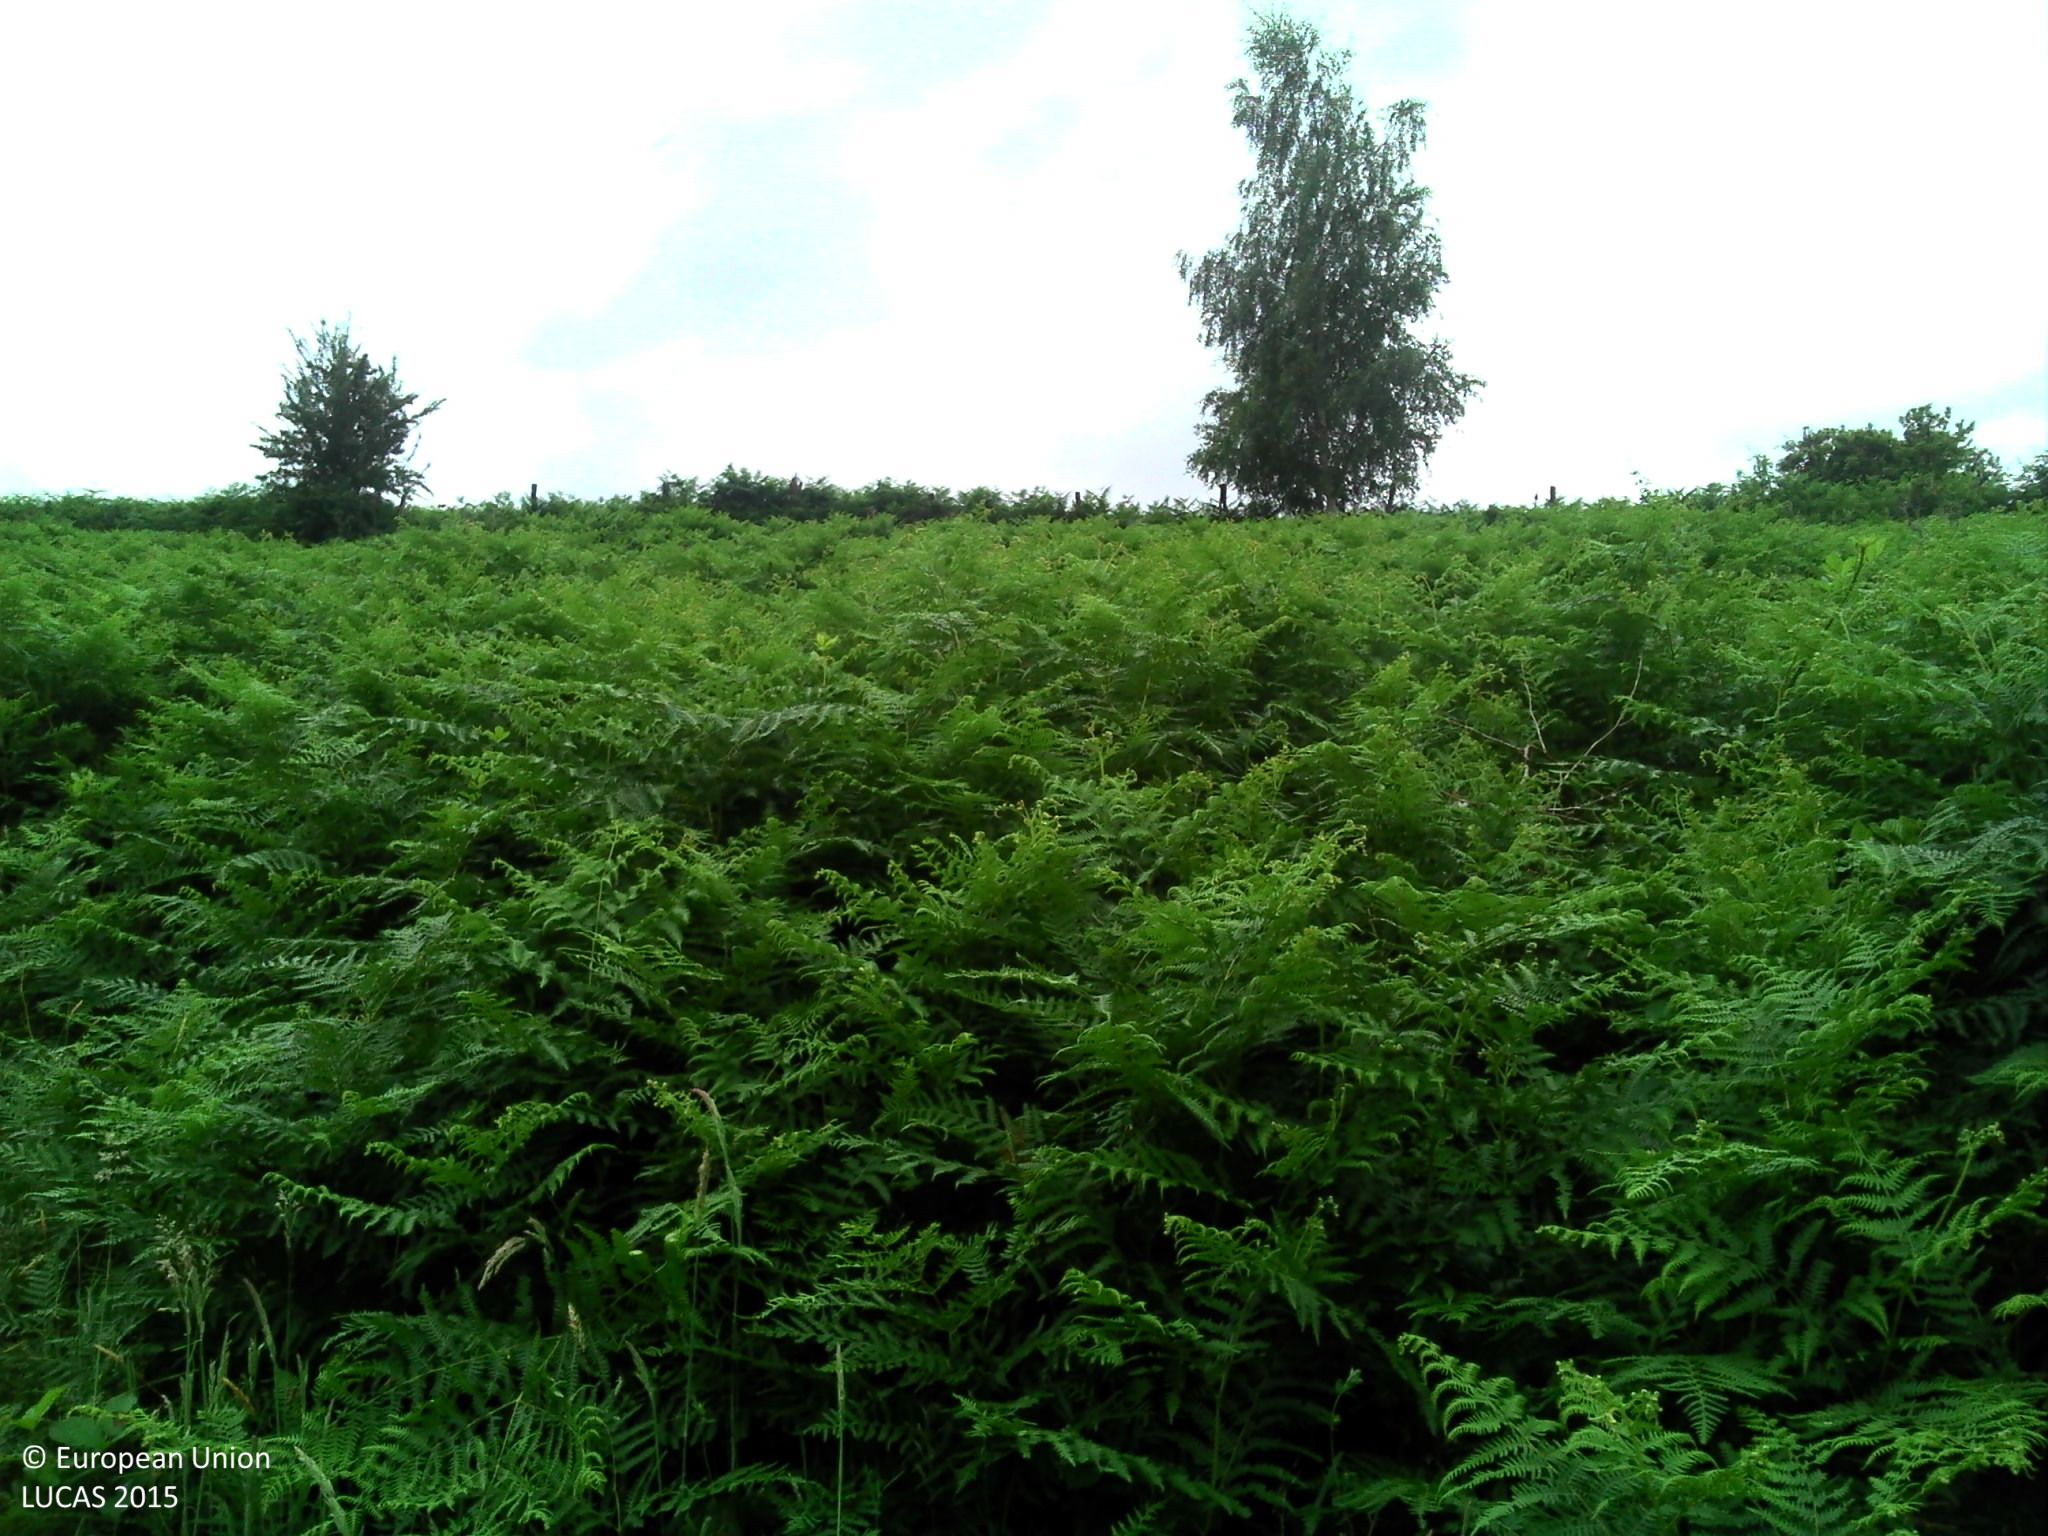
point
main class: Grassland
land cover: Spontaneously vegetated surfaces
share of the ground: > 75 %
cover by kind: herbaceous plants 100 %
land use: Agriculture (excluding fallow land and kitchen gardens)
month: July
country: FR
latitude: 49.3371
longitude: 0.3246
